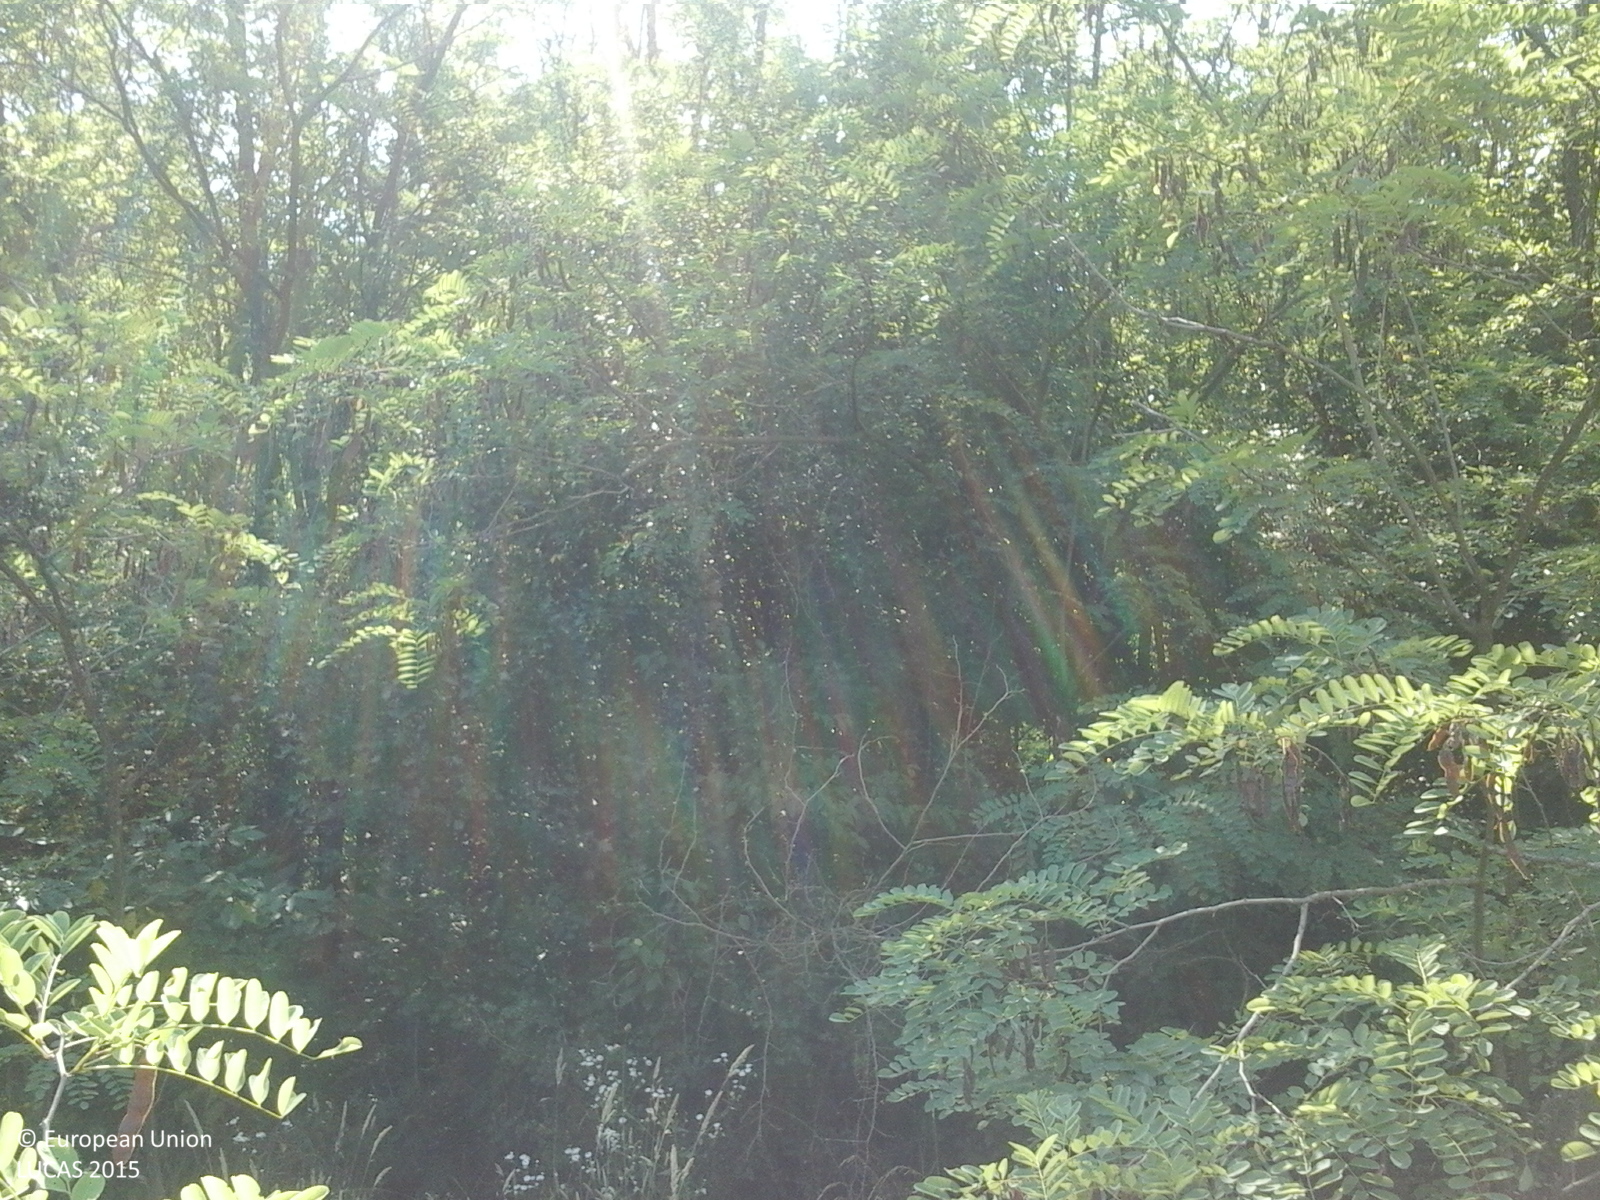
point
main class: Woodland
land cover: Broadleaved woodland
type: thermophilous deciduous forest
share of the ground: > 75 %
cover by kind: broadleaved forest trees 100 %
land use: Forestry
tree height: > 5 m
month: July
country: RO
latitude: 44.8397
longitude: 24.5344
